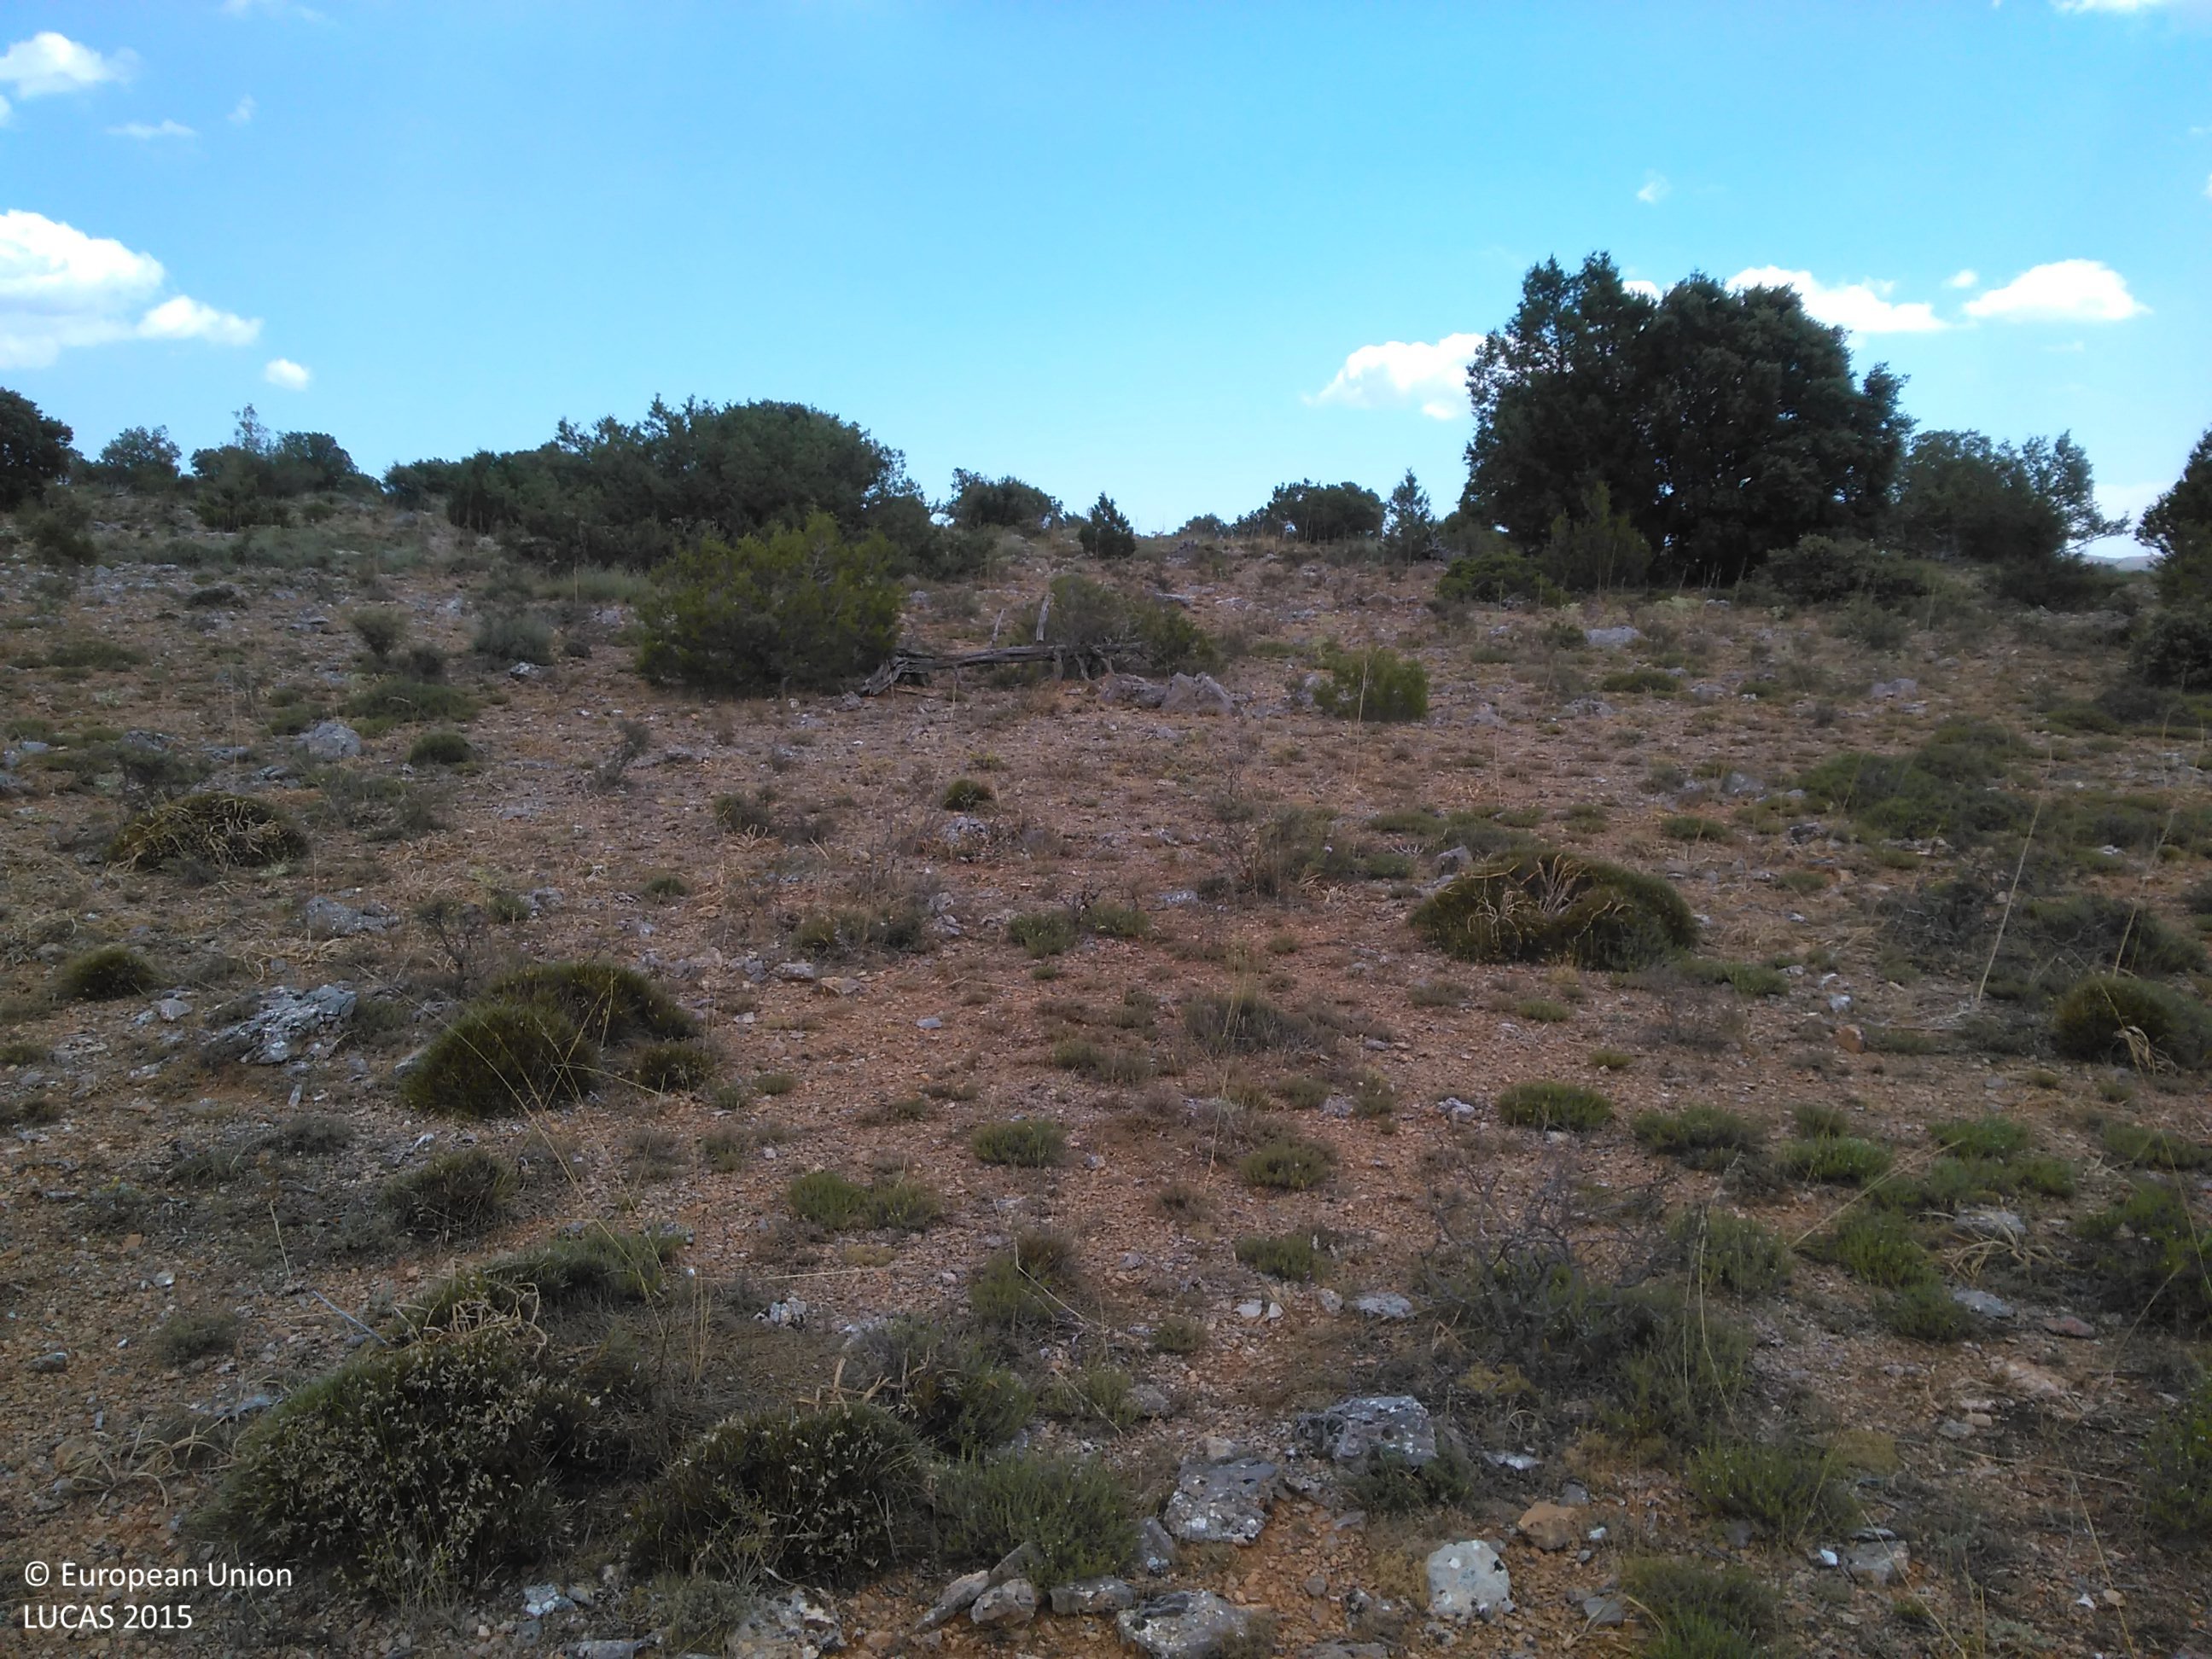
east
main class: Shrubland
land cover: Shrubland with sparse tree cover
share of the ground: 25 - 50 %
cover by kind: unconsolidated bare surface 50 %, shrubs 35 %, herbaceous plants 10 %, broadleaved forest trees 5 %
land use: Semi-natural and natural areas not in use
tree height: < 5 m
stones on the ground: > 50 %
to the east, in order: Shrubland with sparse tree cover; Other mixed woodland
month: July
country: ES
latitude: 41.6186
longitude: -1.9240
